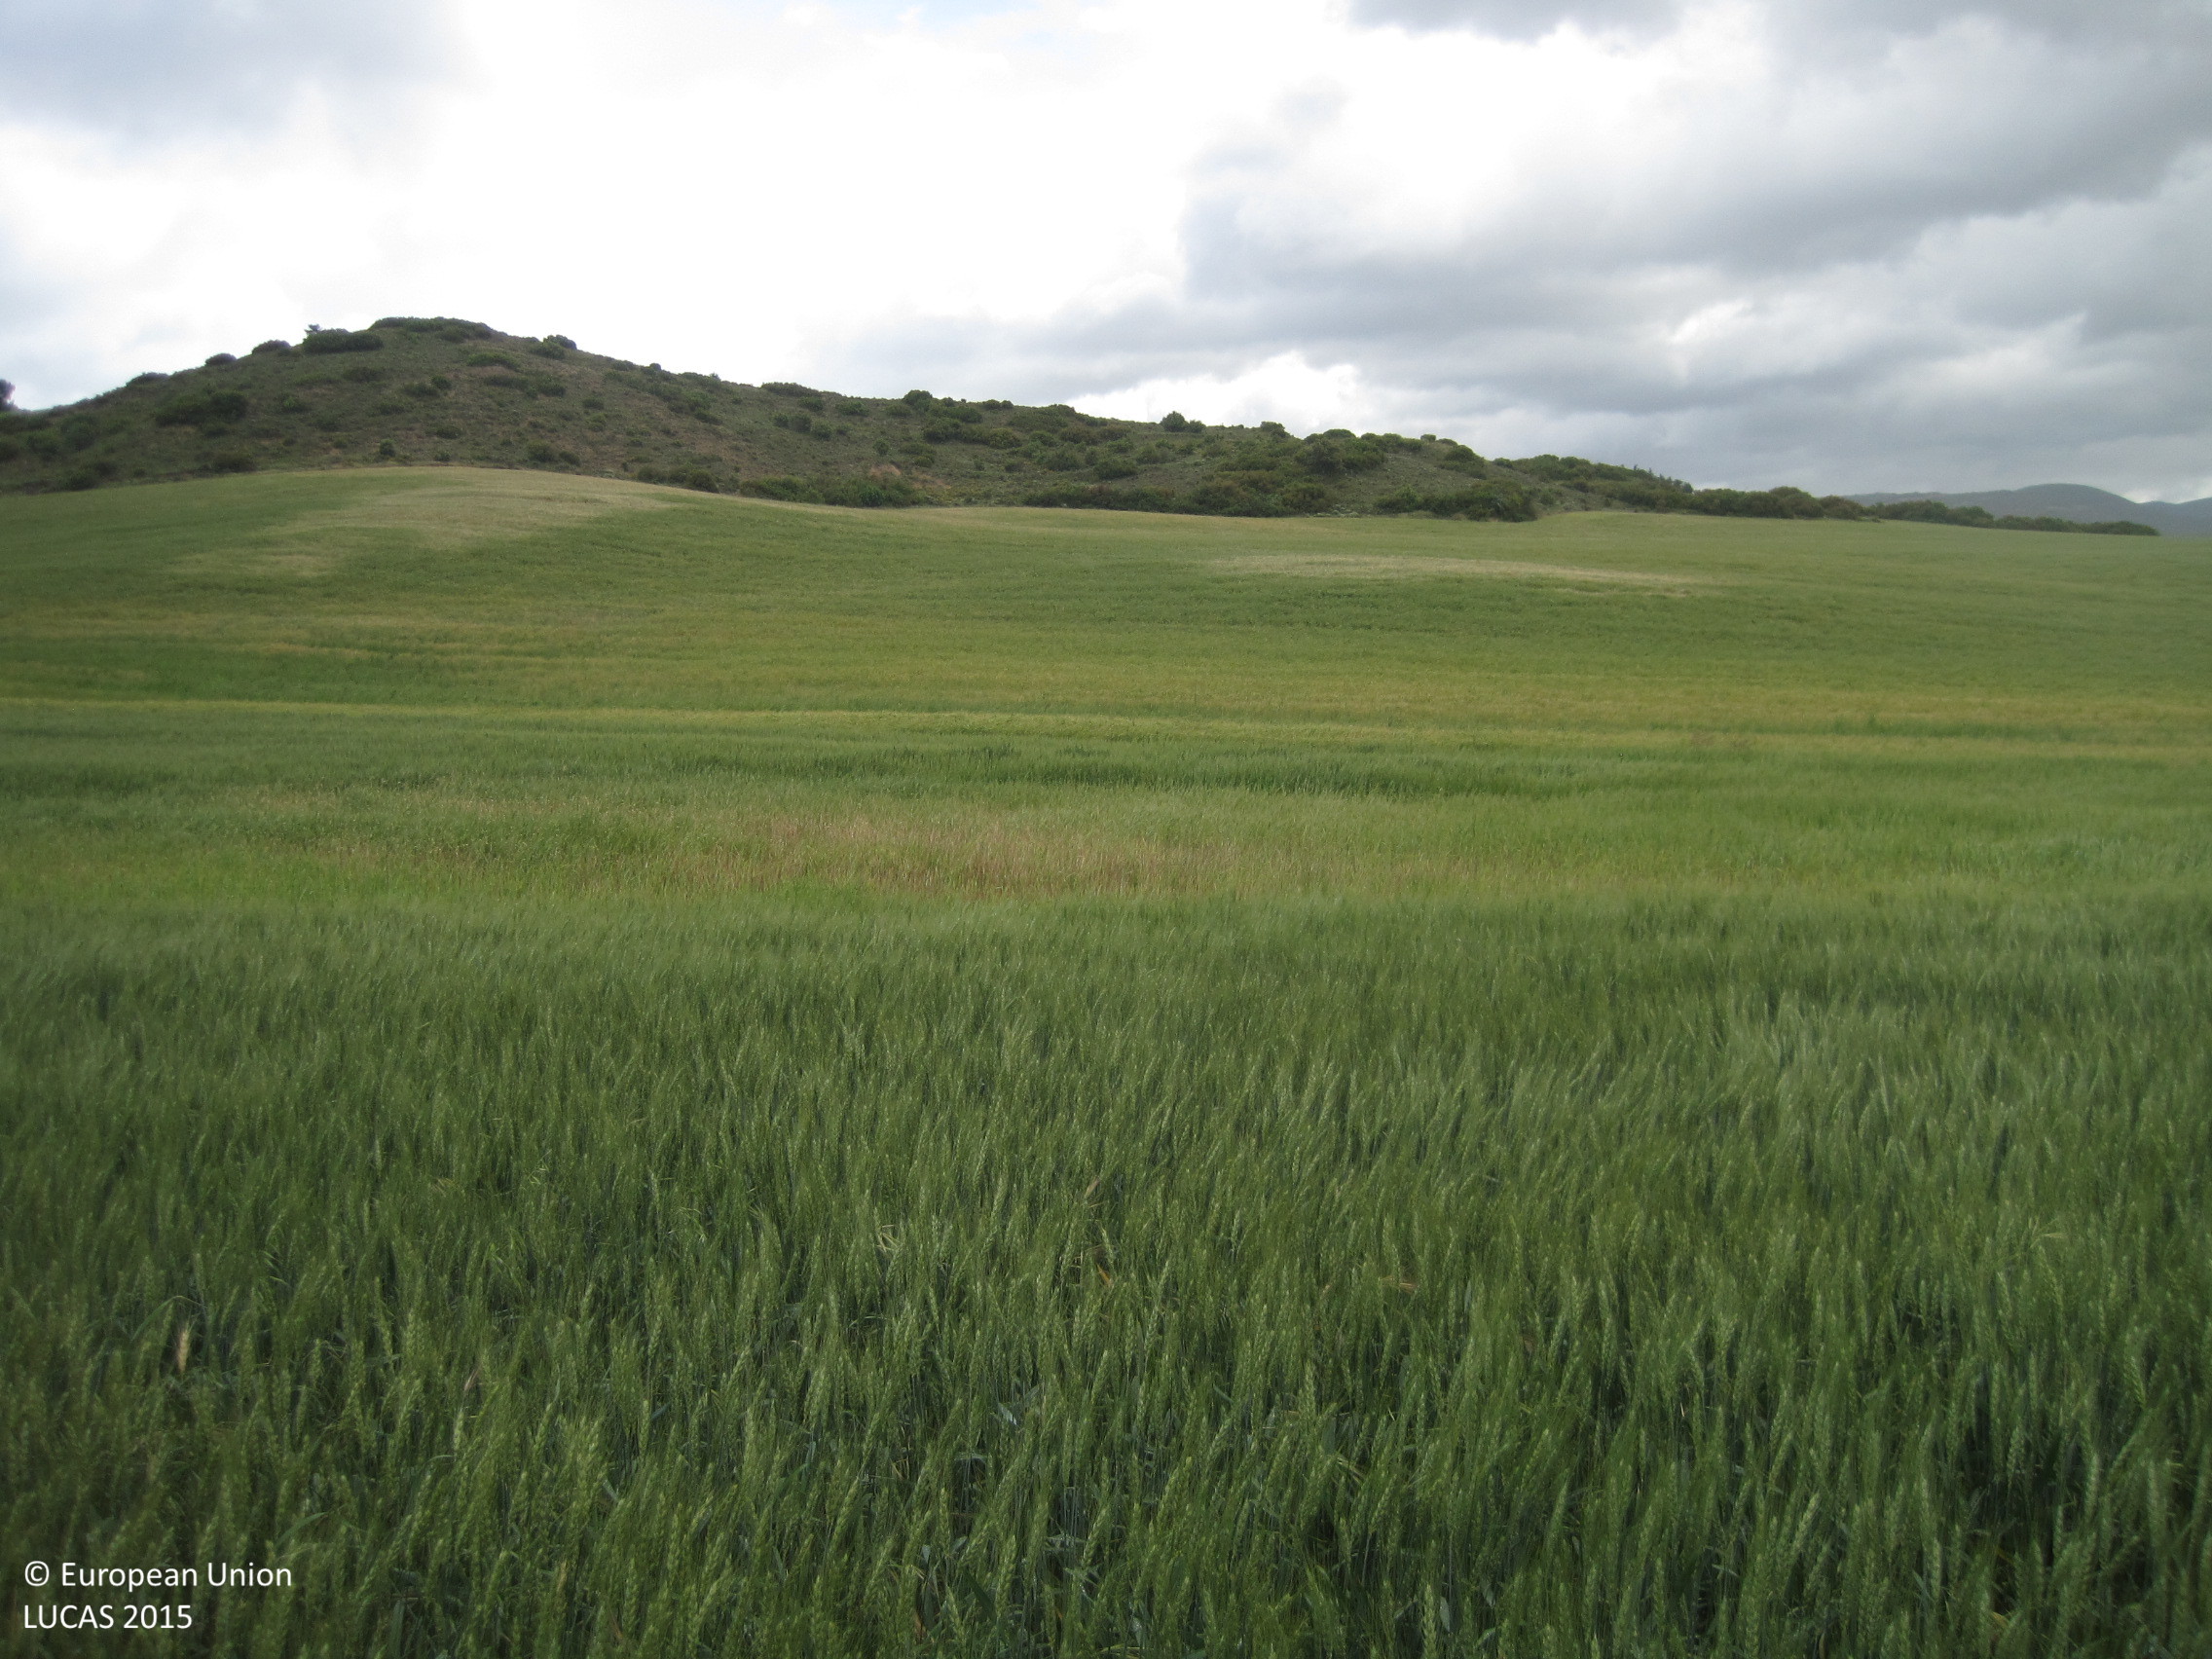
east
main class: Cropland
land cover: Durum wheat
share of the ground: > 75 %
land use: Agriculture (excluding fallow land and kitchen gardens)
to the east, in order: Durum wheat; Ditches and canals; Barley
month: May
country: ES
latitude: 42.5740
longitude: -1.2290
